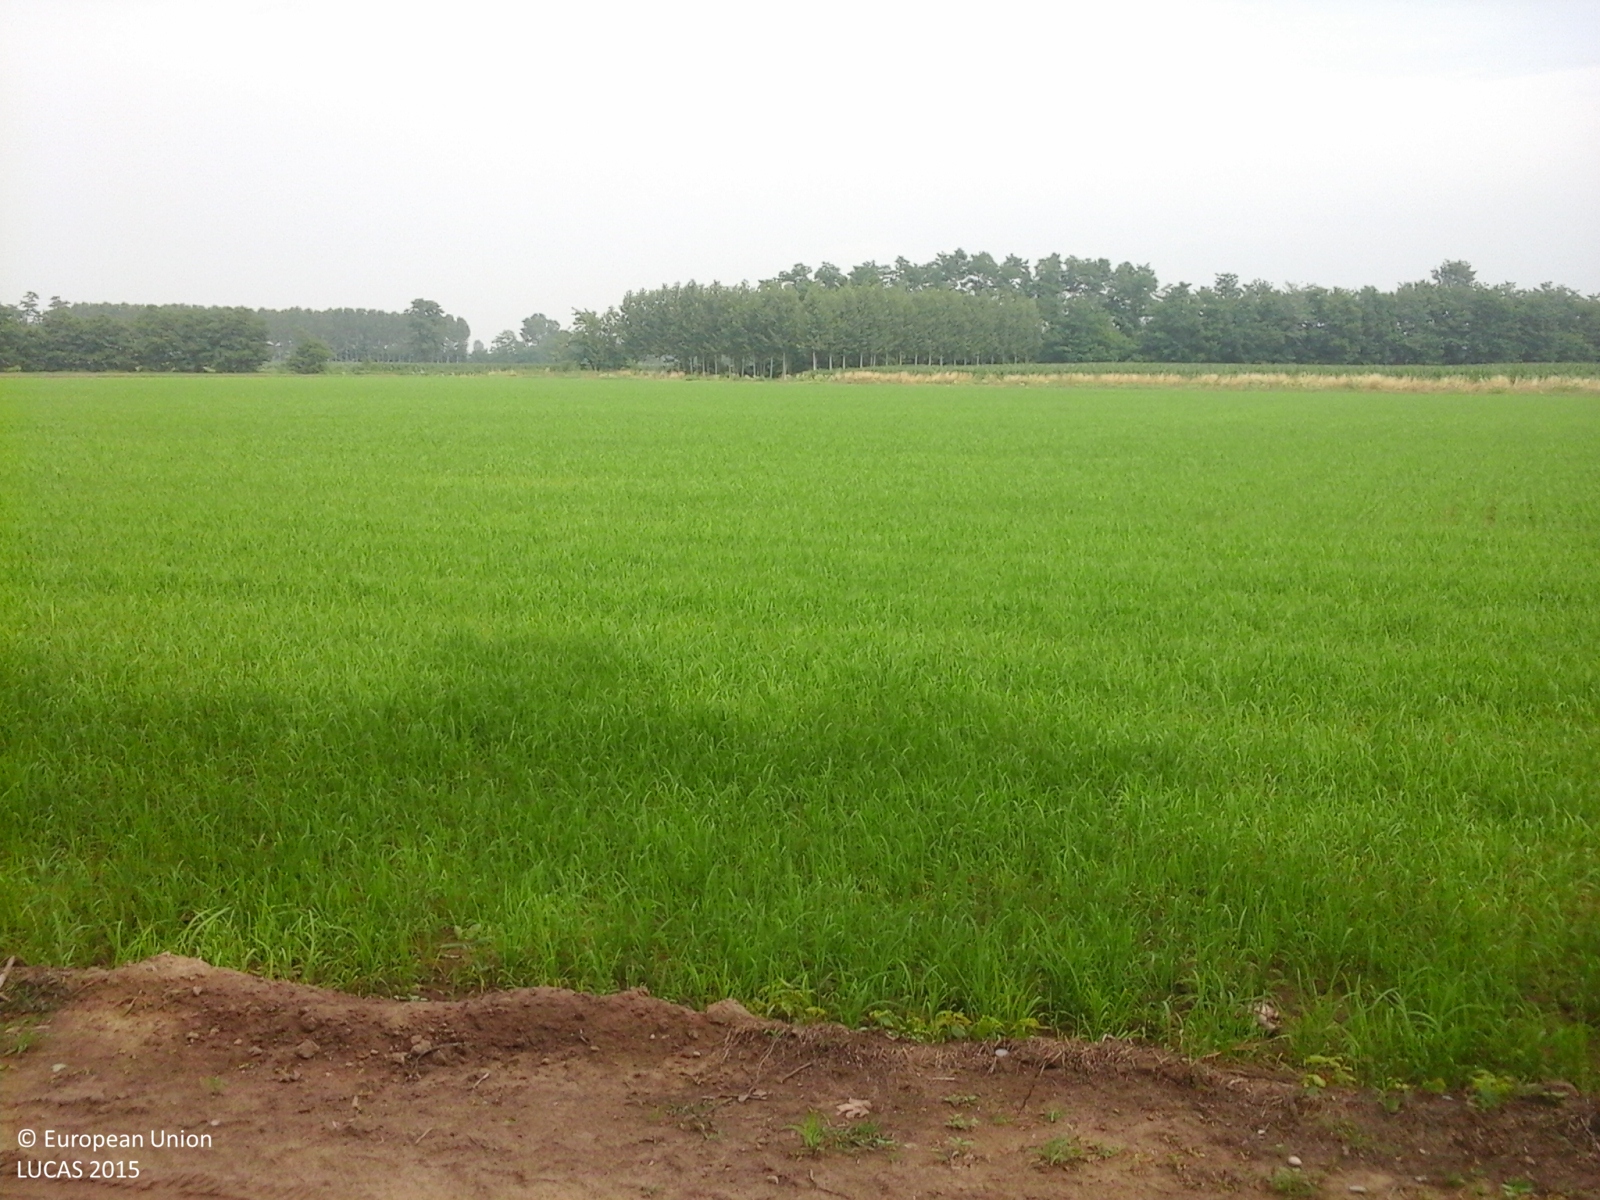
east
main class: Woodland
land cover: Broadleaved woodland
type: thermophilous deciduous forest
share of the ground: > 75 %
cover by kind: broadleaved forest trees 100 %
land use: Forestry
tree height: > 5 m
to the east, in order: Broadleaved woodland; Fences; Broadleaved woodland; Ditches and canals; Grass margins; Tracks; Rice; Grass margins
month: June
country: IT
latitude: 45.1911
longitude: 8.7930
